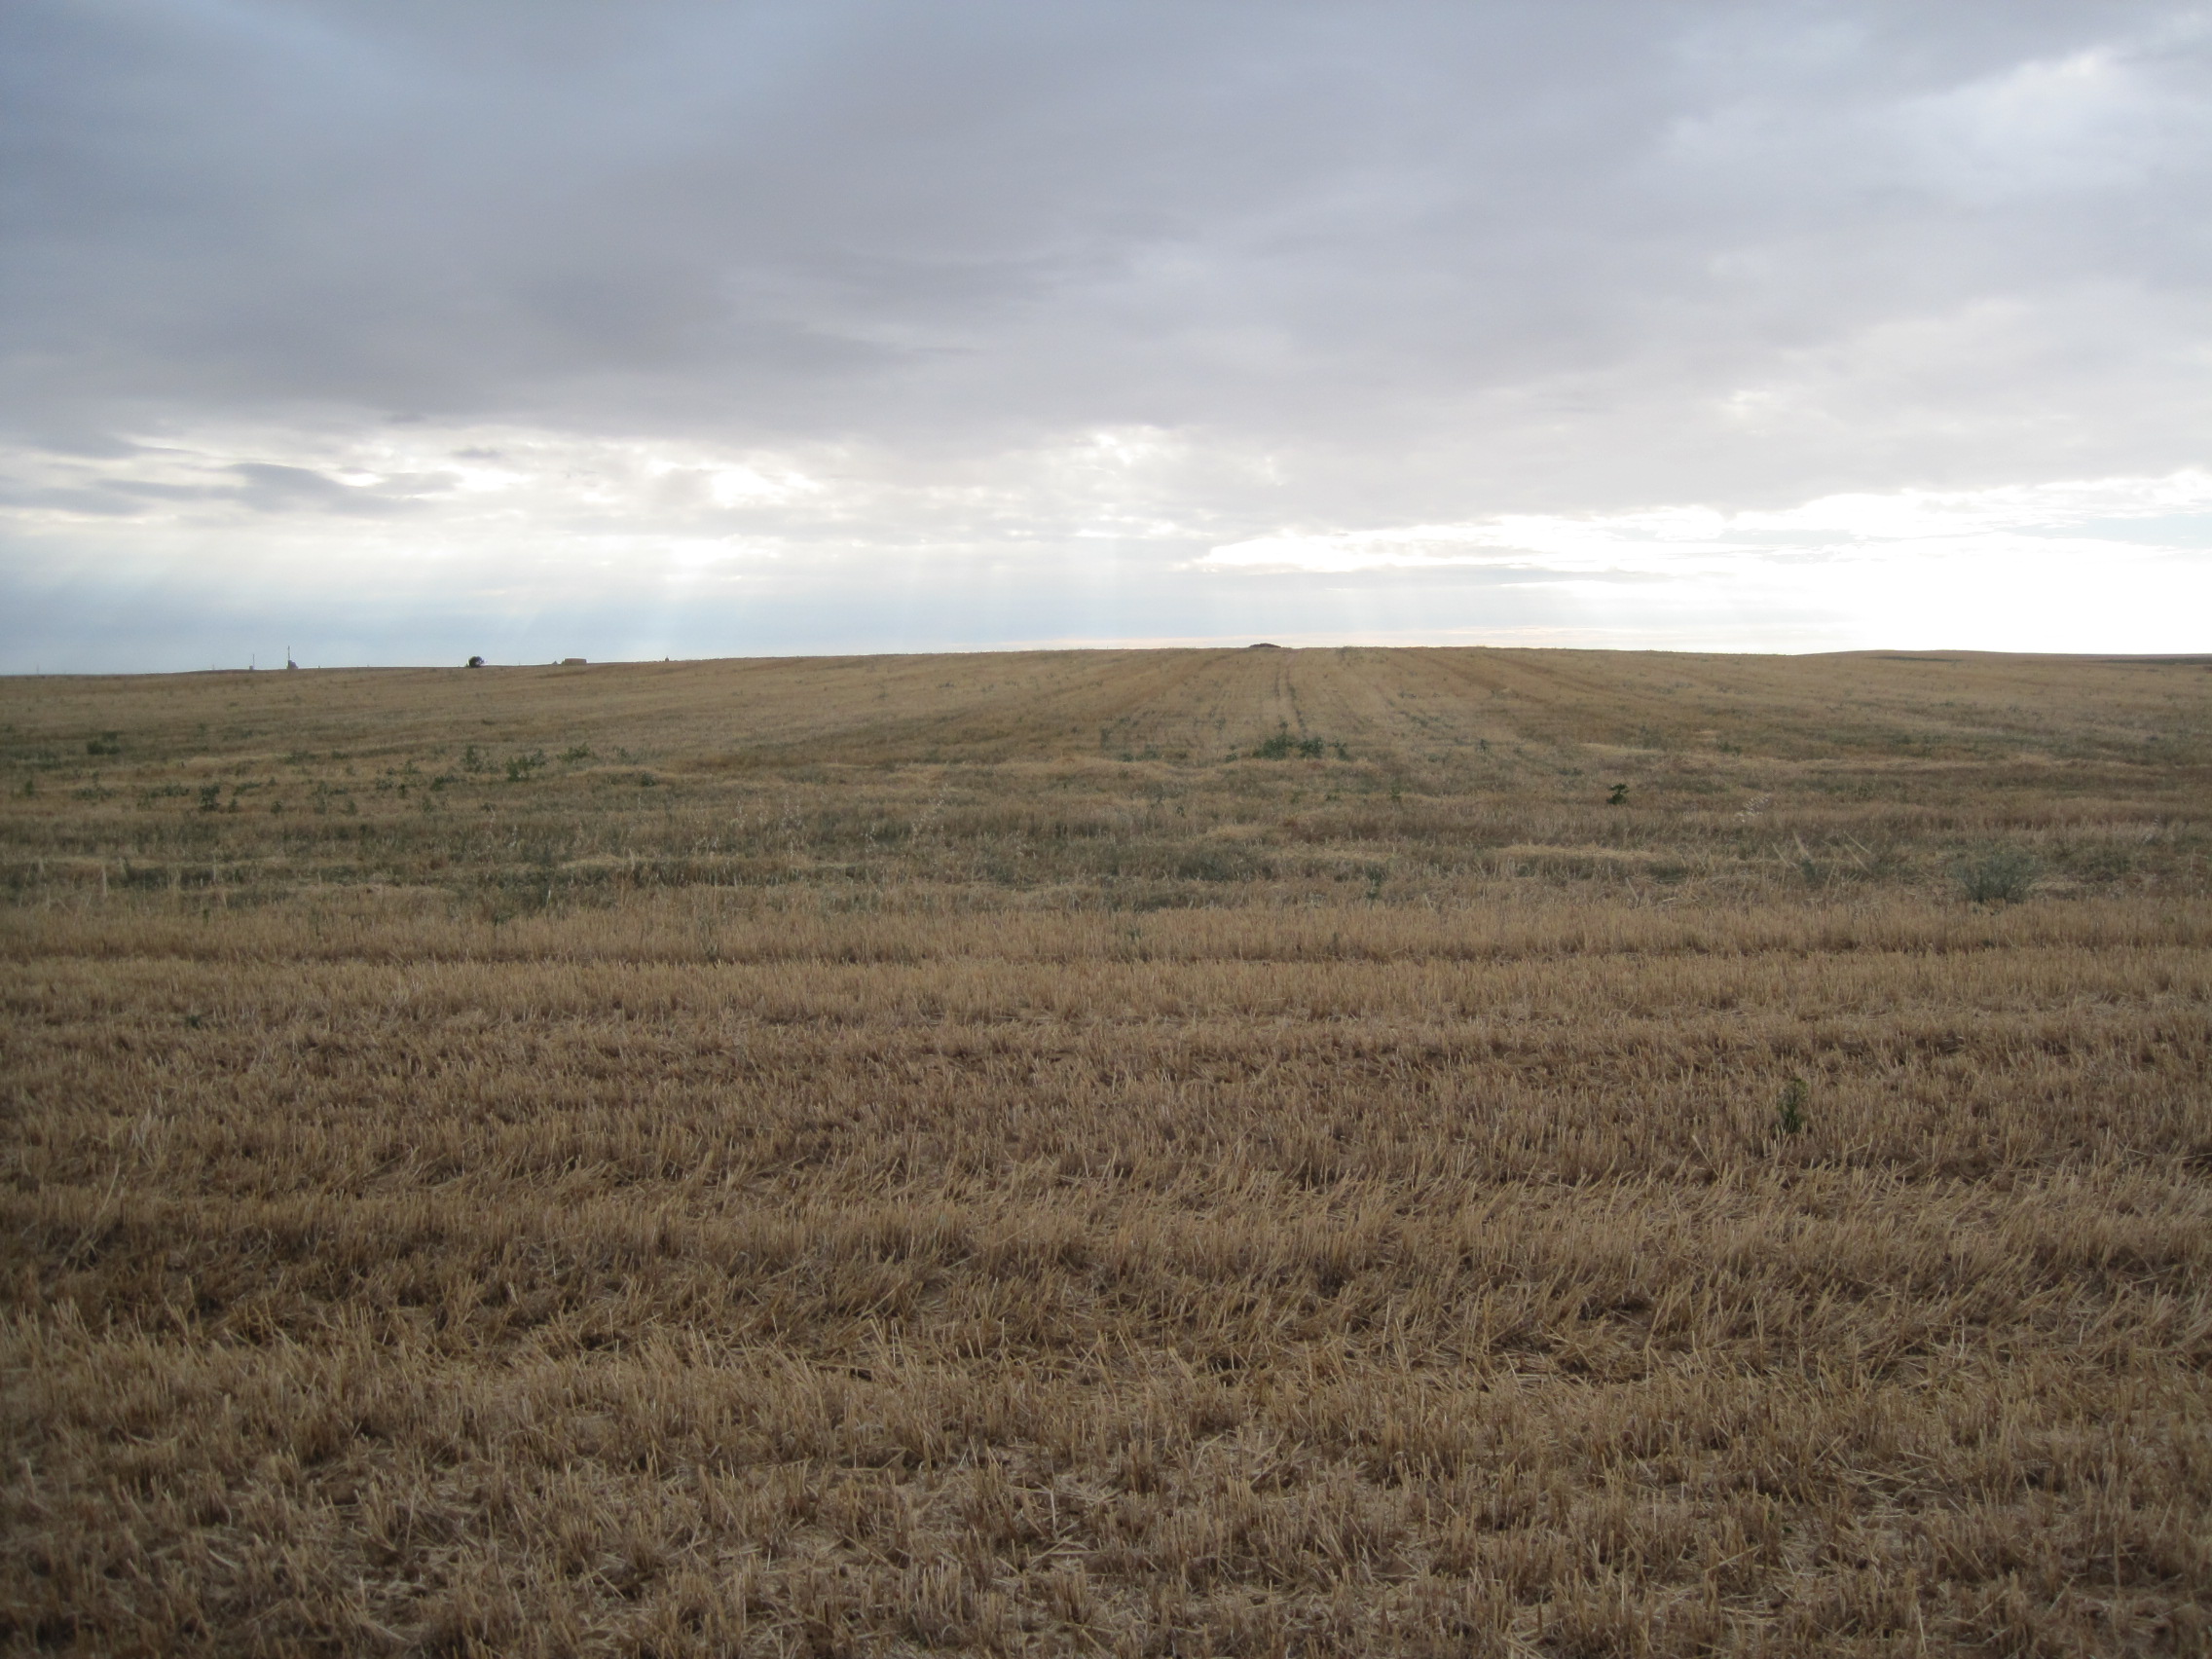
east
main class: Cropland
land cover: Barley
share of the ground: < 10 %
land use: Agriculture (excluding fallow land and kitchen gardens)
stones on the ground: < 10 %
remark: Harvested field
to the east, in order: Barley; Grass margins; Barley
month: July
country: ES
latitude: 41.9743
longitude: -5.4493
